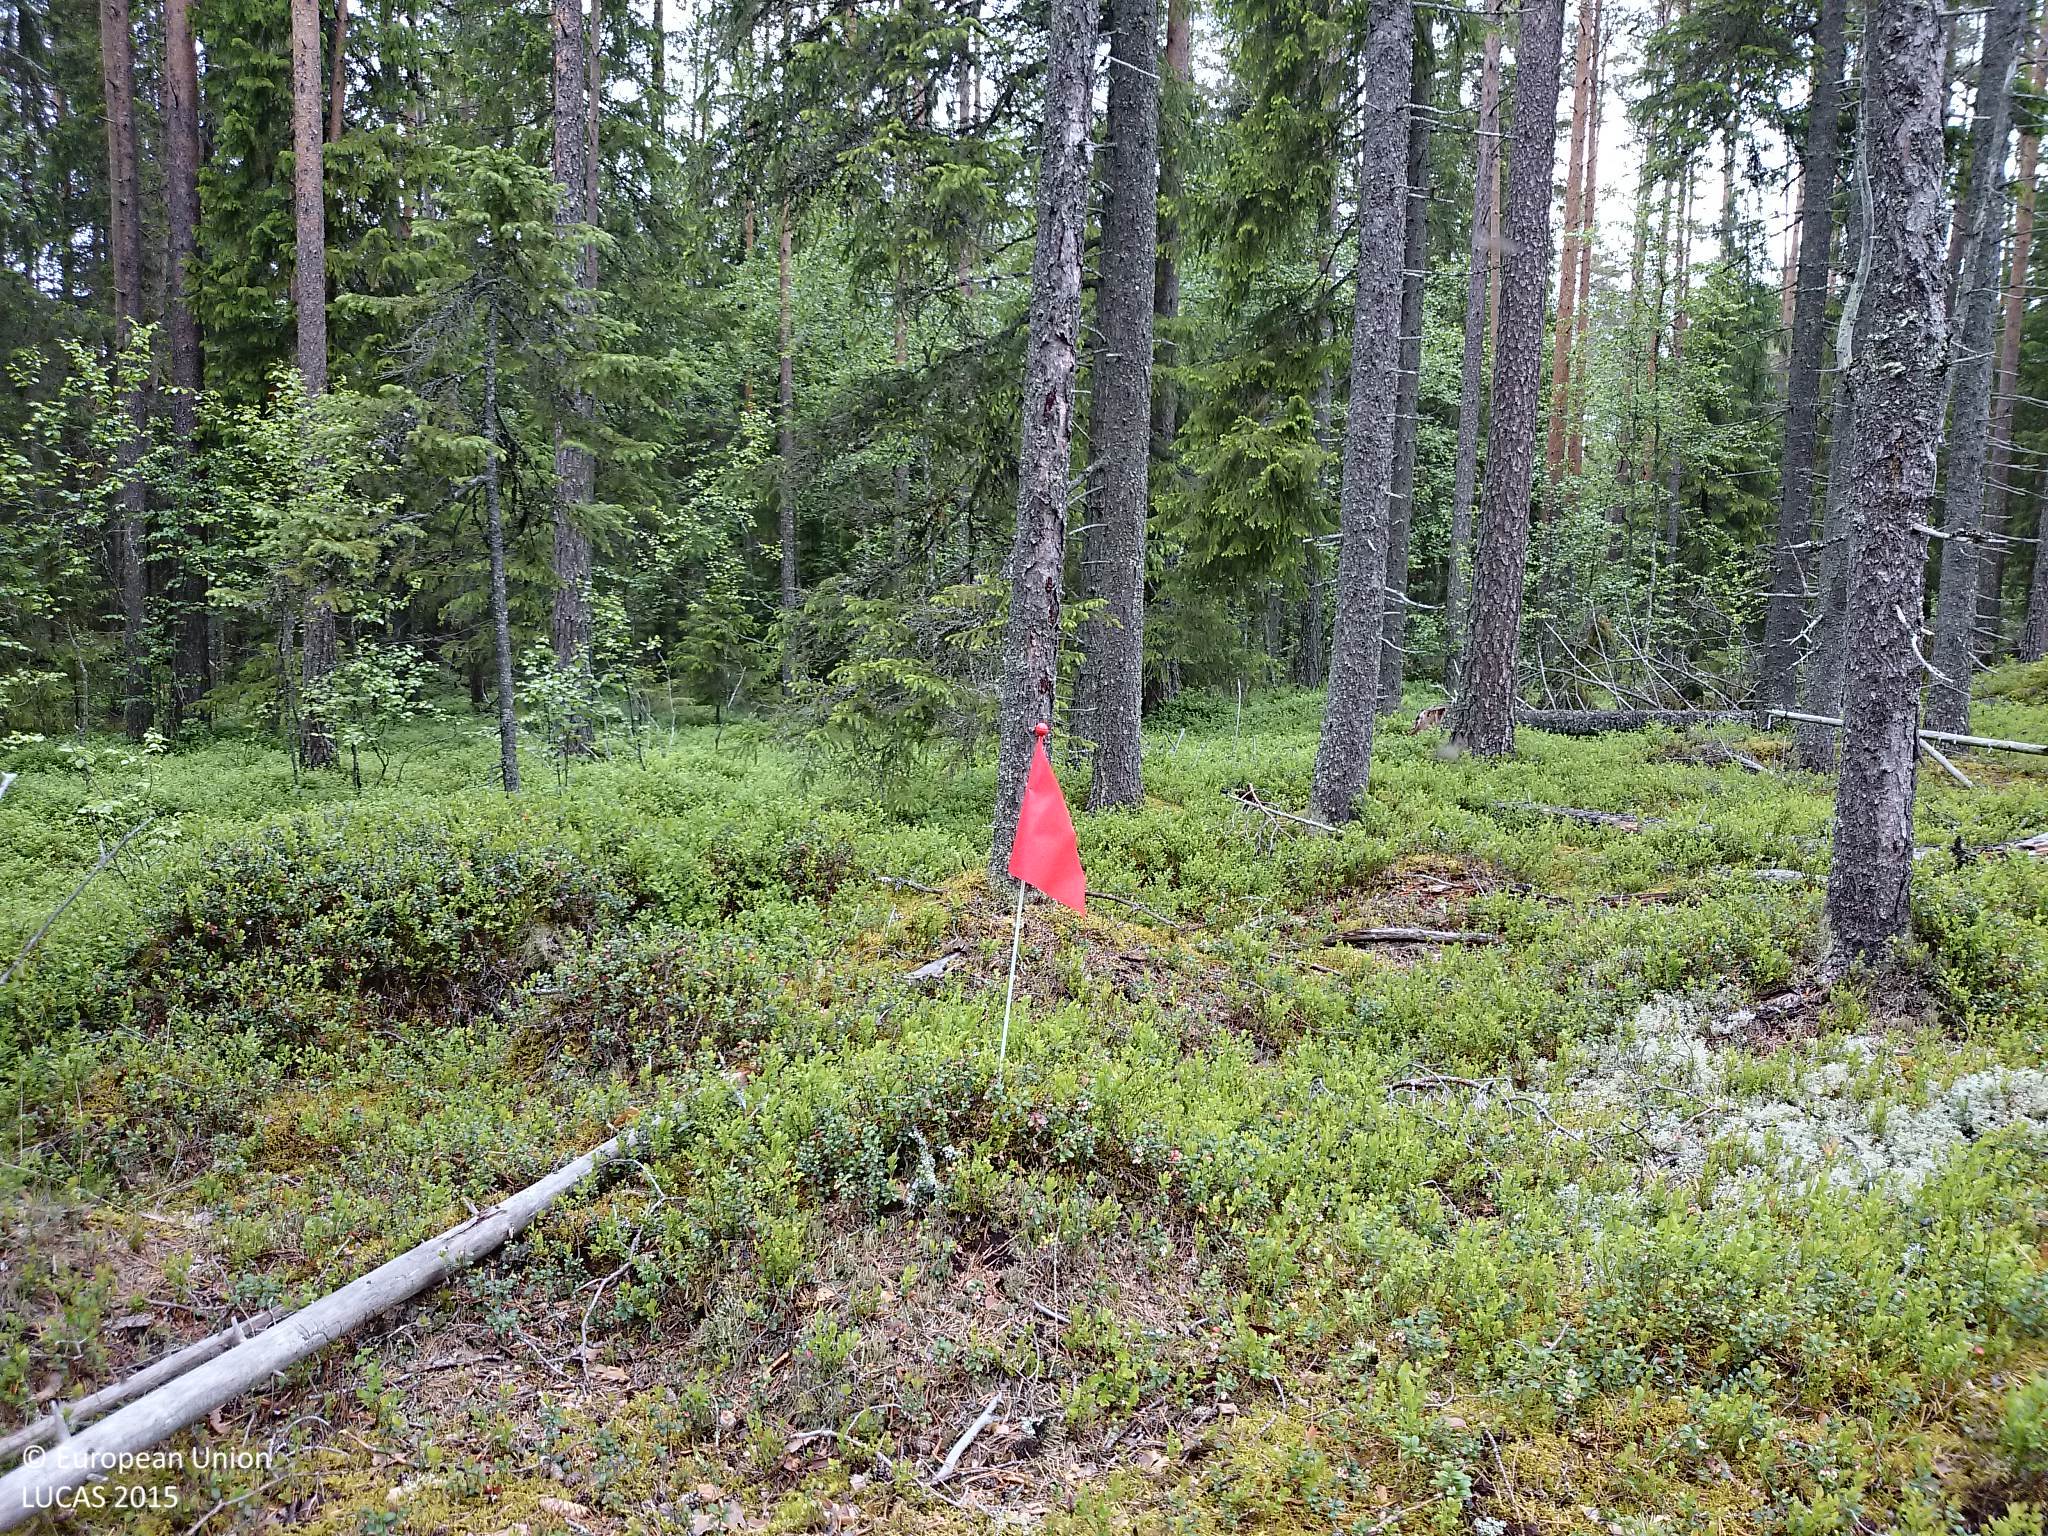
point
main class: Woodland
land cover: Pine dominated mixed woodland
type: boreal forest
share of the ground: > 75 %
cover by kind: coniferous forest trees 60 %, broadleaved forest trees 20 %, shrubs 20 %
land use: Forestry
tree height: > 5 m
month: June
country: SE
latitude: 64.1253
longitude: 20.7237
